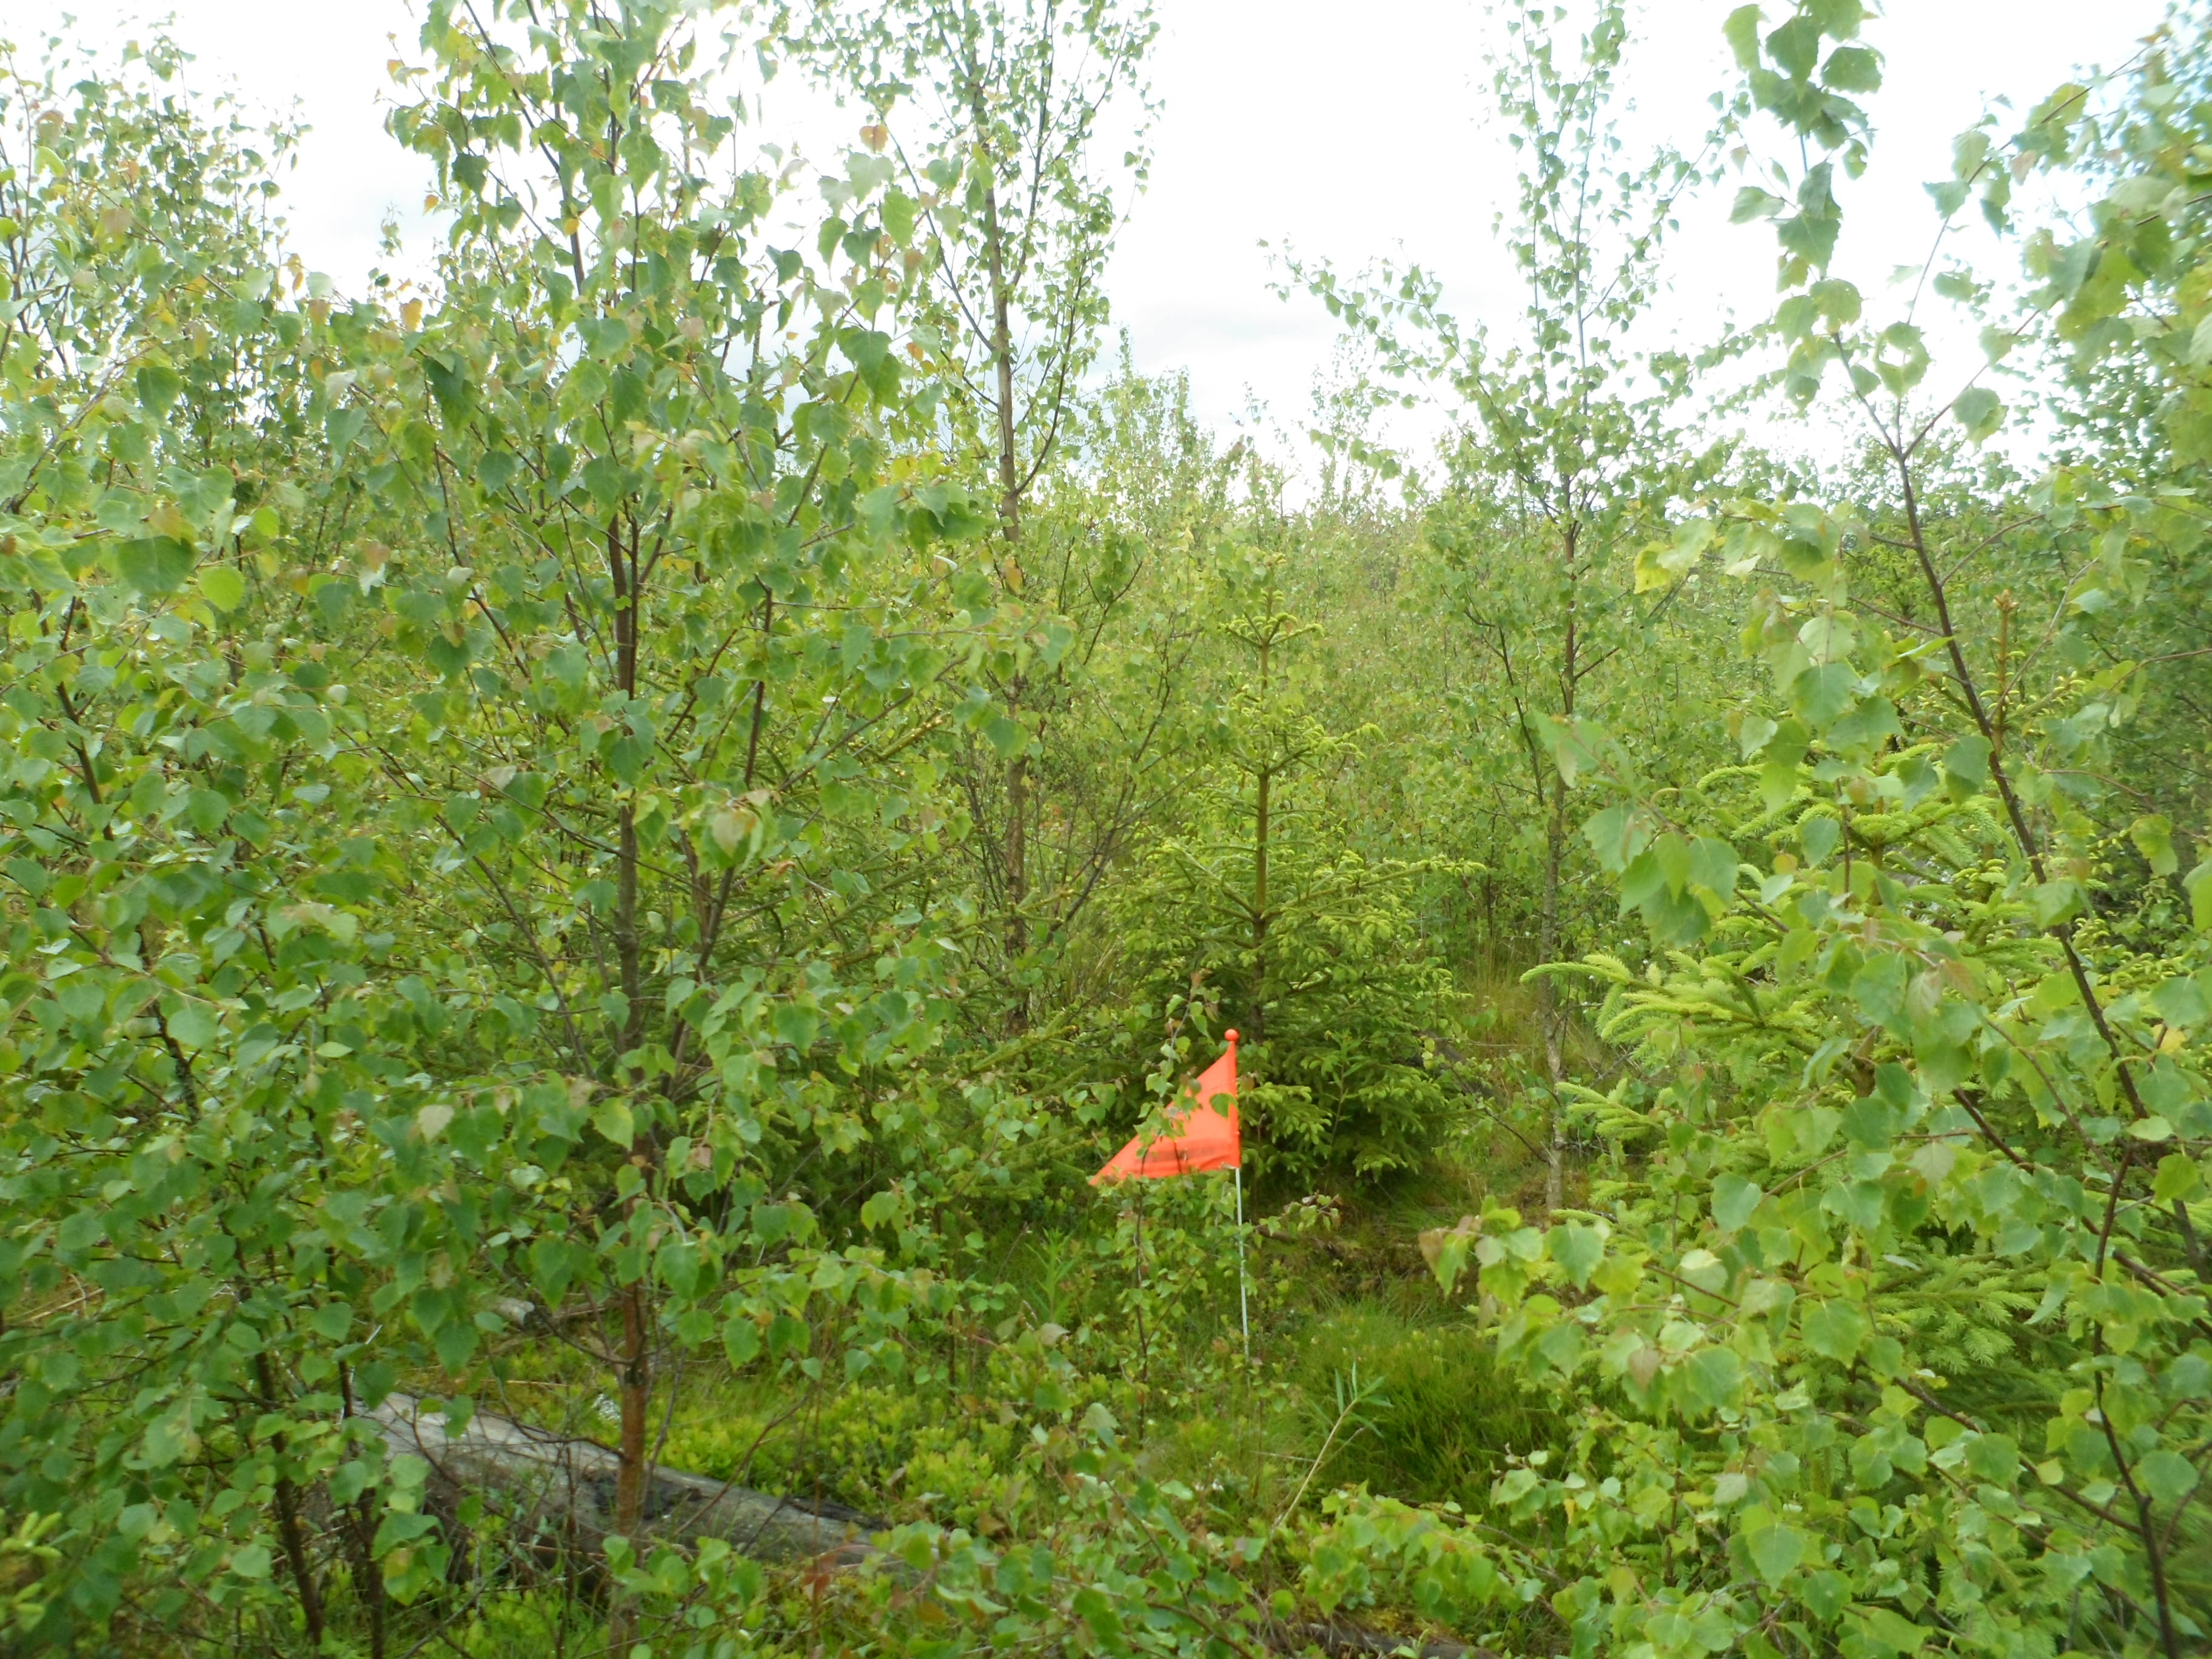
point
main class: Woodland
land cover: Spruce dominated mixed woodland
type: boreal forest
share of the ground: > 75 %
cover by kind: broadleaved forest trees 45 %, coniferous forest trees 35 %, shrubs 10 %, herbaceous plants 10 %
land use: Forestry
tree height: > 5 m
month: June
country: SE
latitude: 57.0096
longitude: 14.4921
